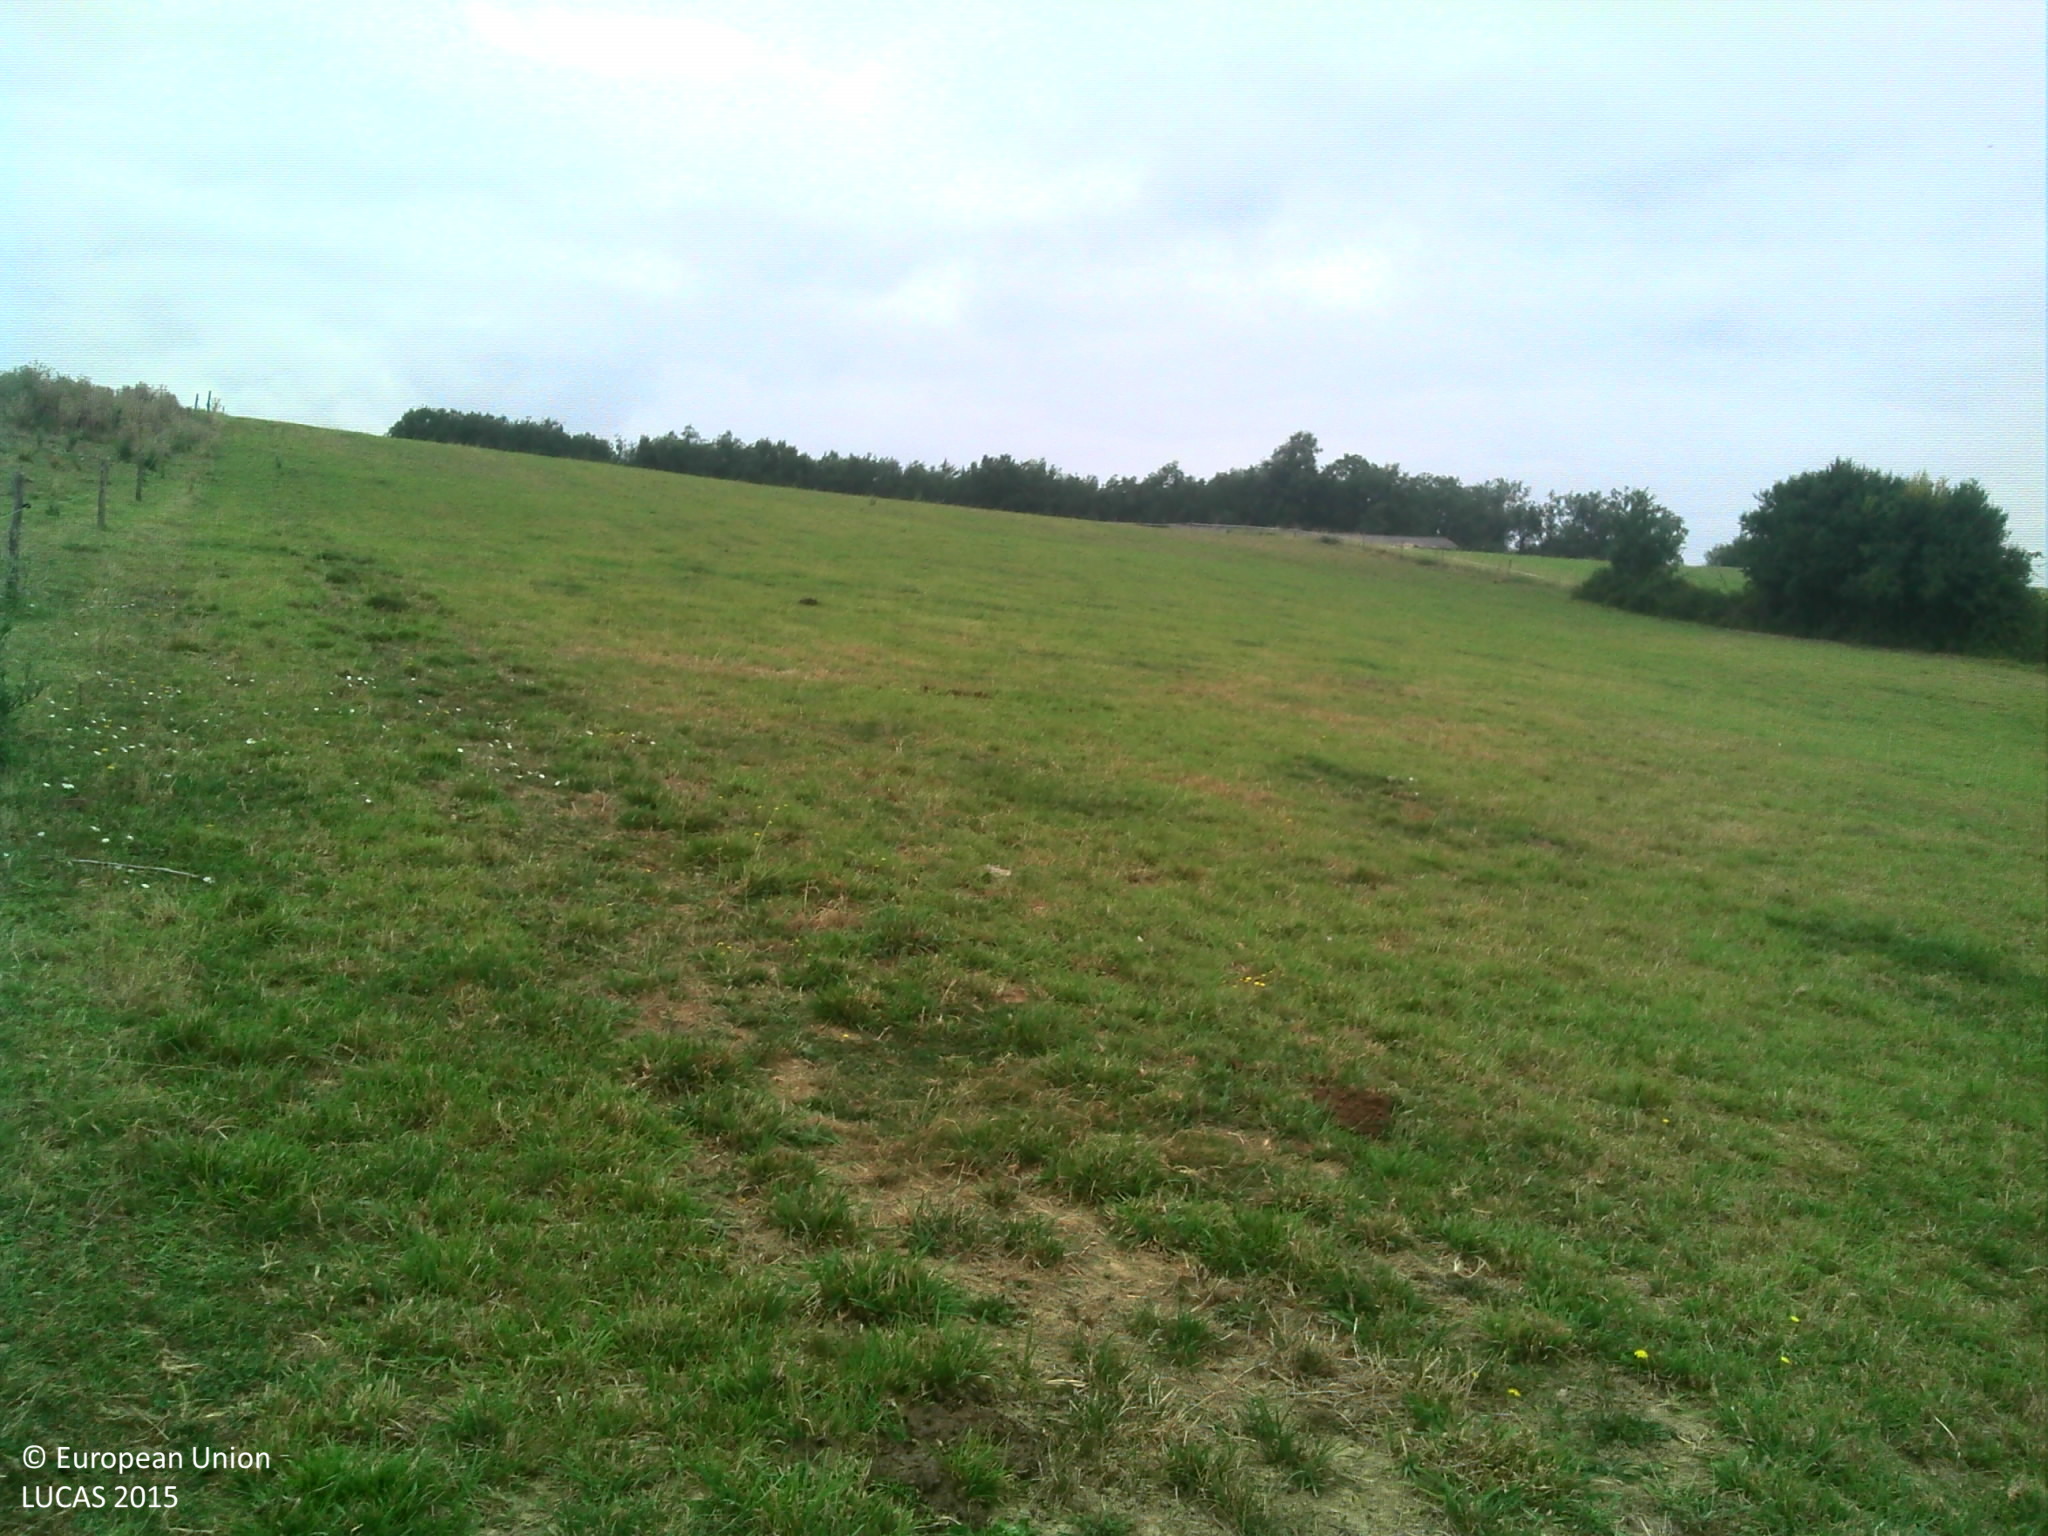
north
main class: Grassland
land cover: Grassland without tree/shrub cover
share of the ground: > 75 %
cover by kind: herbaceous plants 100 %
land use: Agriculture (excluding fallow land and kitchen gardens)
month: July
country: FR
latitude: 44.0250
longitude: 0.9274
